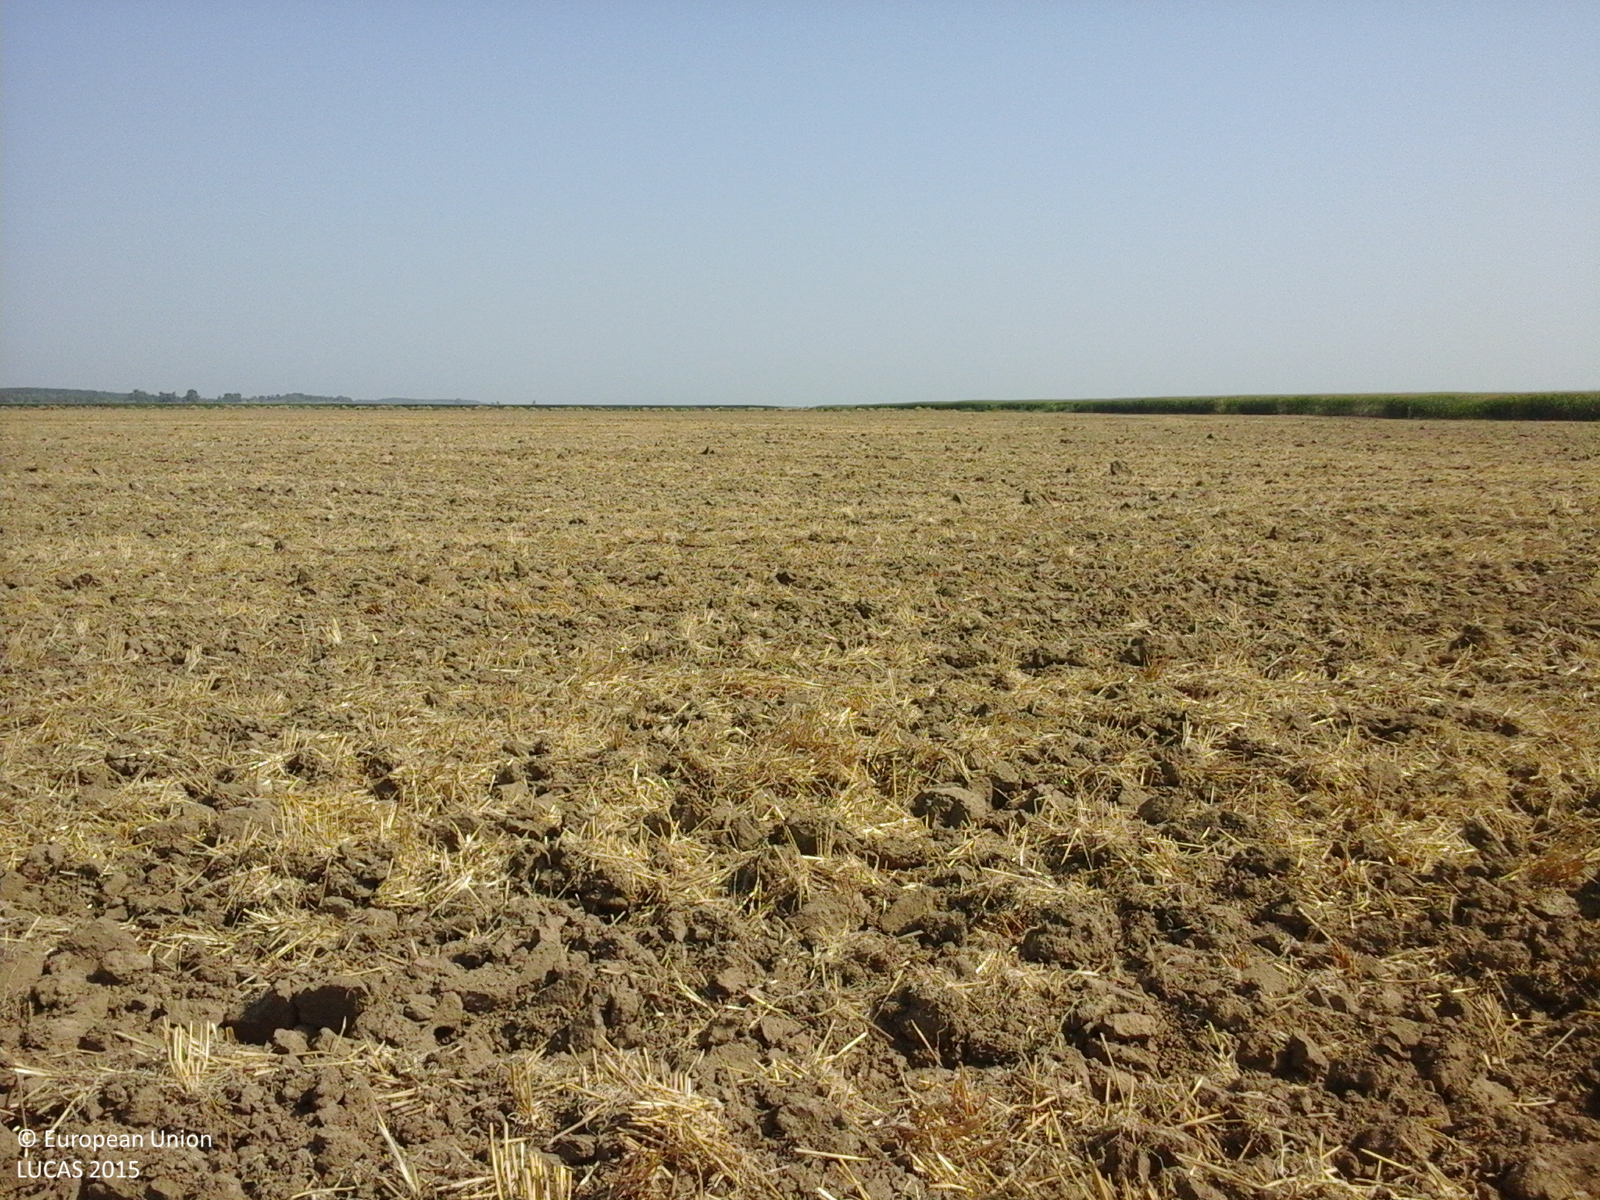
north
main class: Cropland
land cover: Barley
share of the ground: < 10 %
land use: Agriculture (excluding fallow land and kitchen gardens)
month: August
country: RO
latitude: 44.9468
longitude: 27.9430
